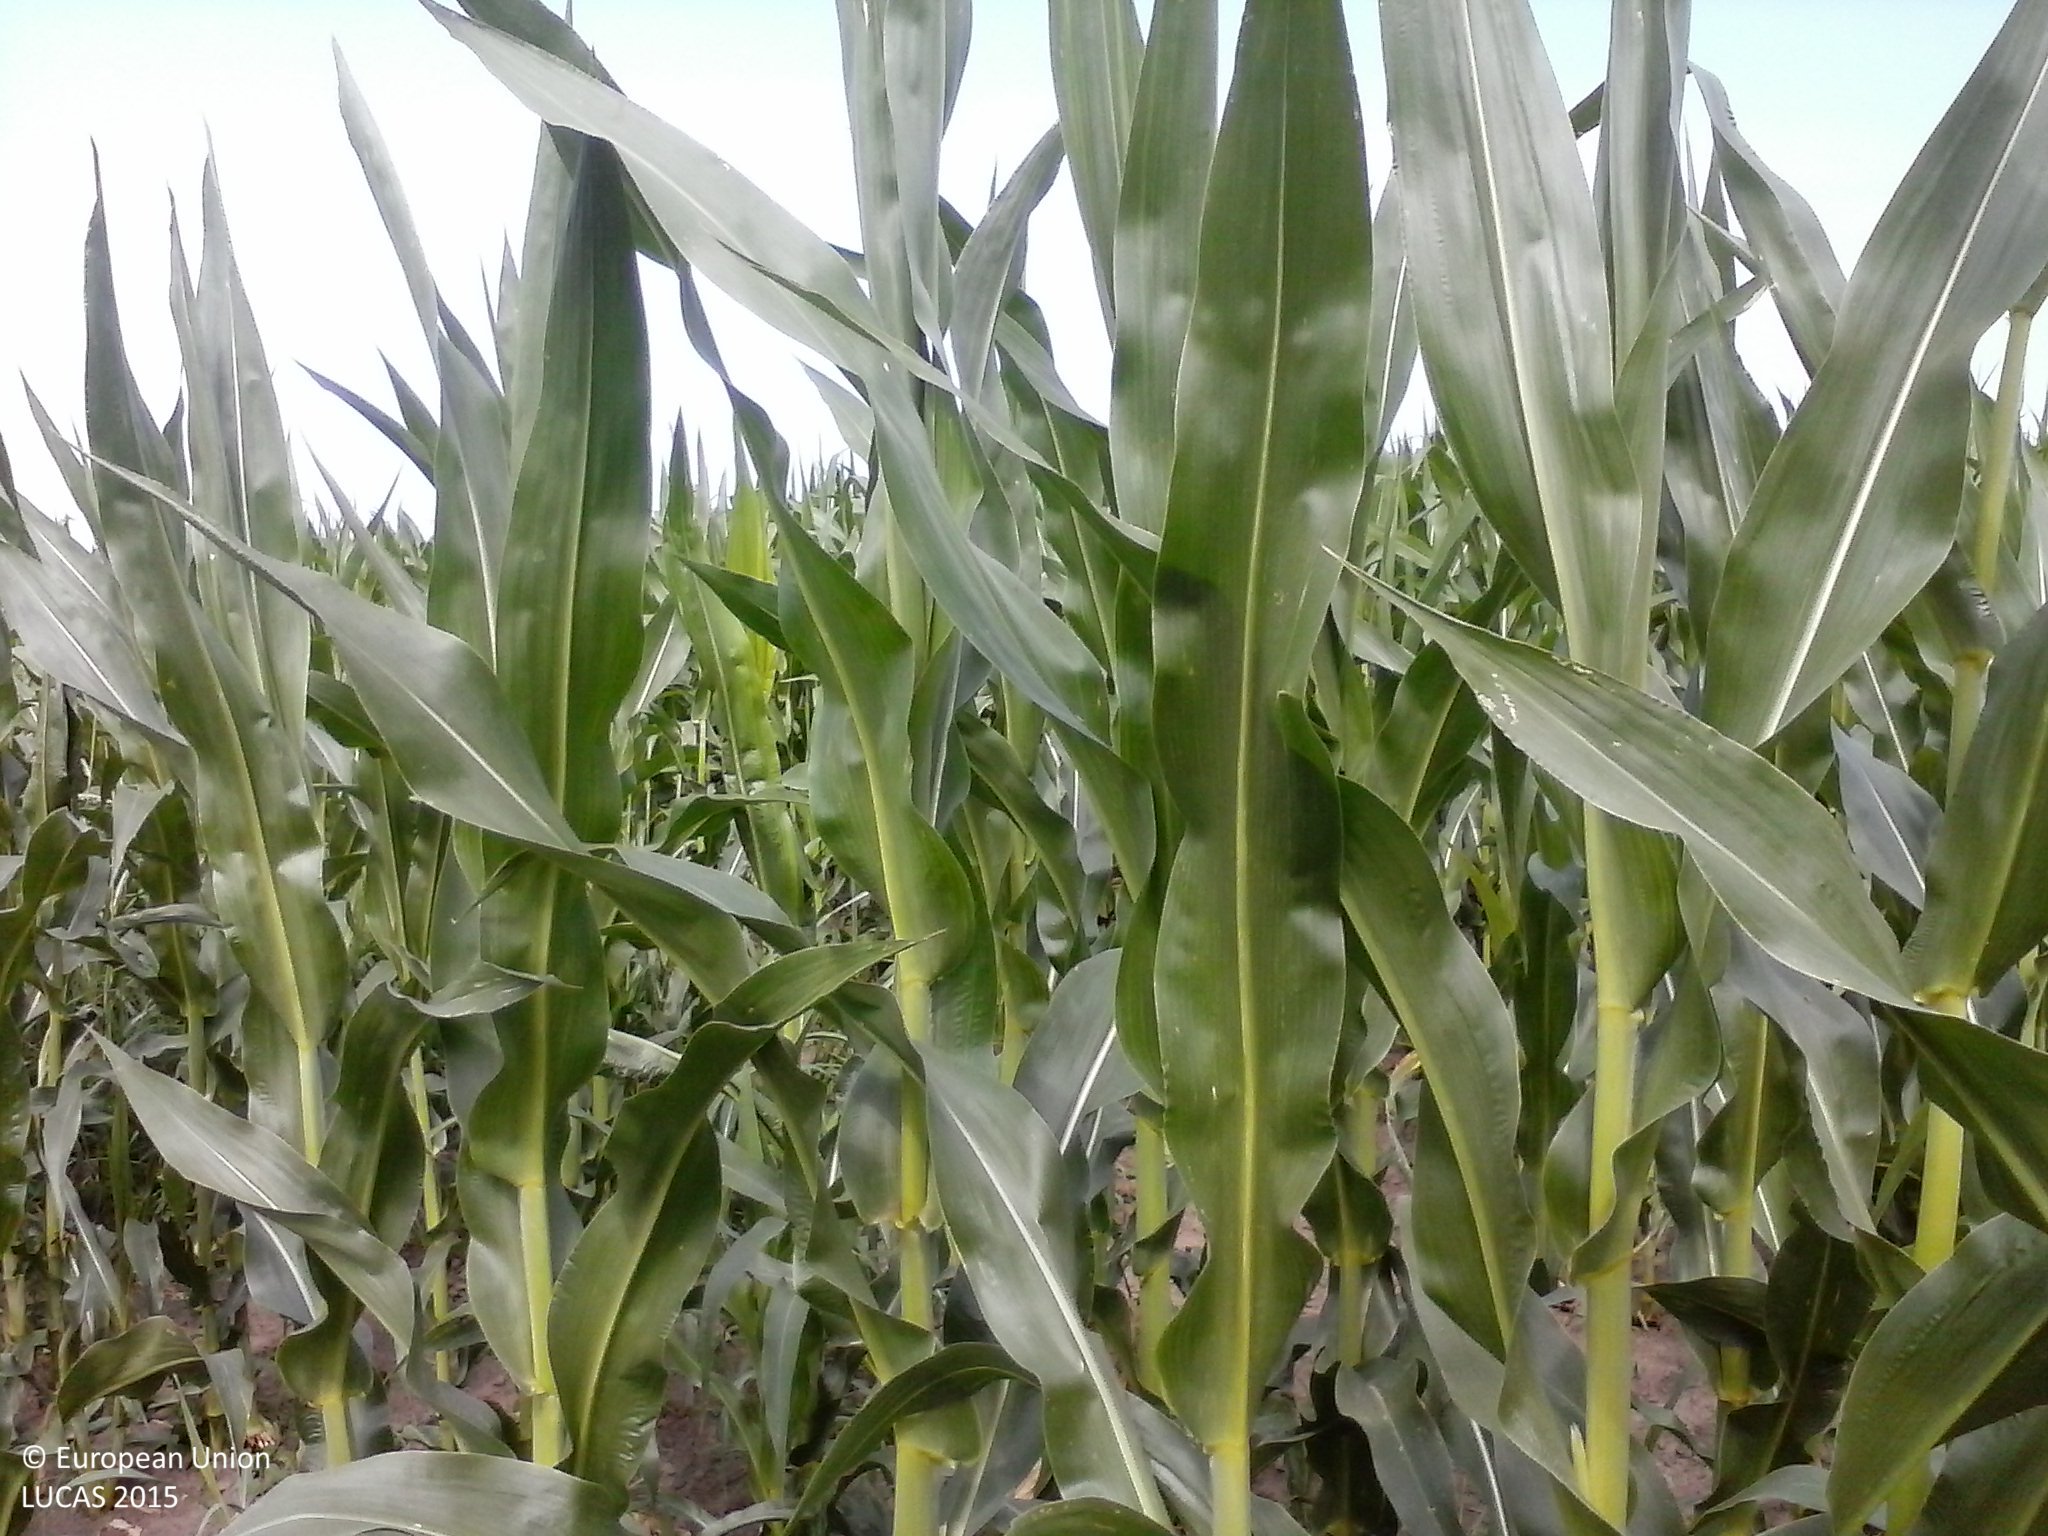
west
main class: Cropland
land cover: Maize
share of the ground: > 75 %
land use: Agriculture (excluding fallow land and kitchen gardens)
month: June
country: HU
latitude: 46.1981
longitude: 19.5150
